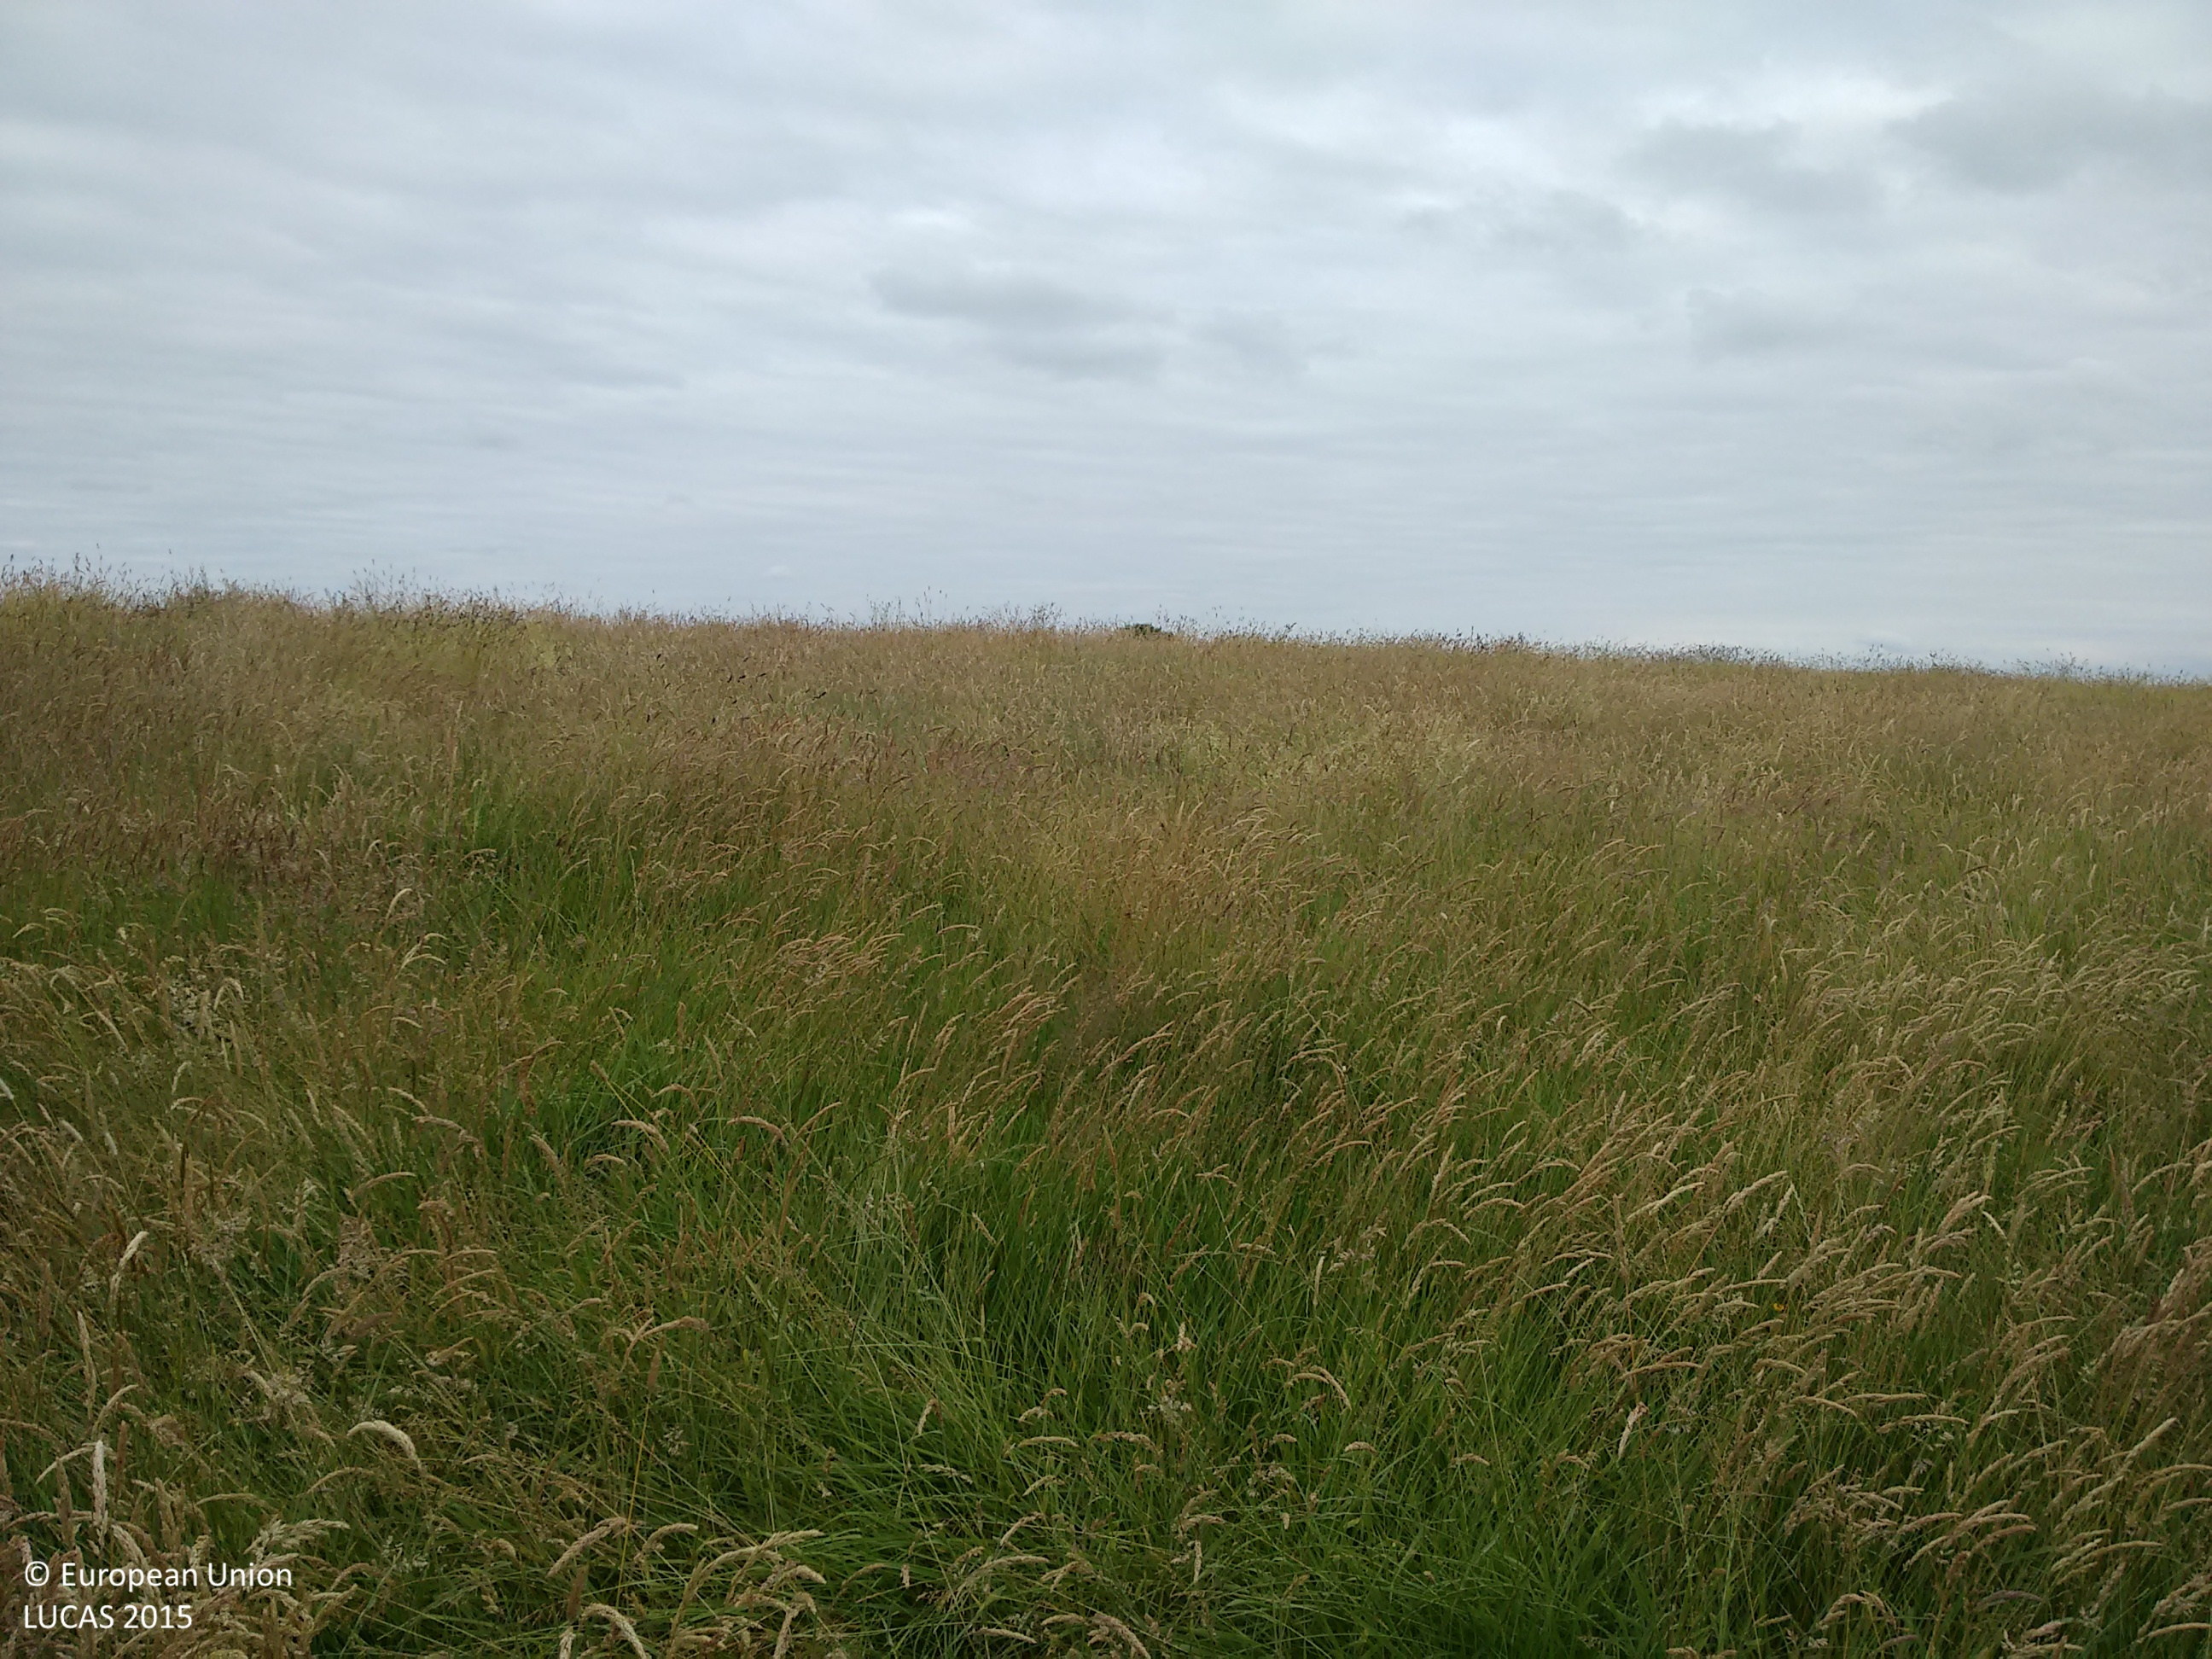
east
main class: Grassland
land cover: Grassland without tree/shrub cover
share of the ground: > 75 %
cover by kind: herbaceous plants 100 %
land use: Agriculture (excluding fallow land and kitchen gardens)
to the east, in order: Grassland without tree/shrub cover; Fences; Managed hedges; Apple fruit
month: July
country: IE
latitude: 53.4678
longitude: -7.6837
